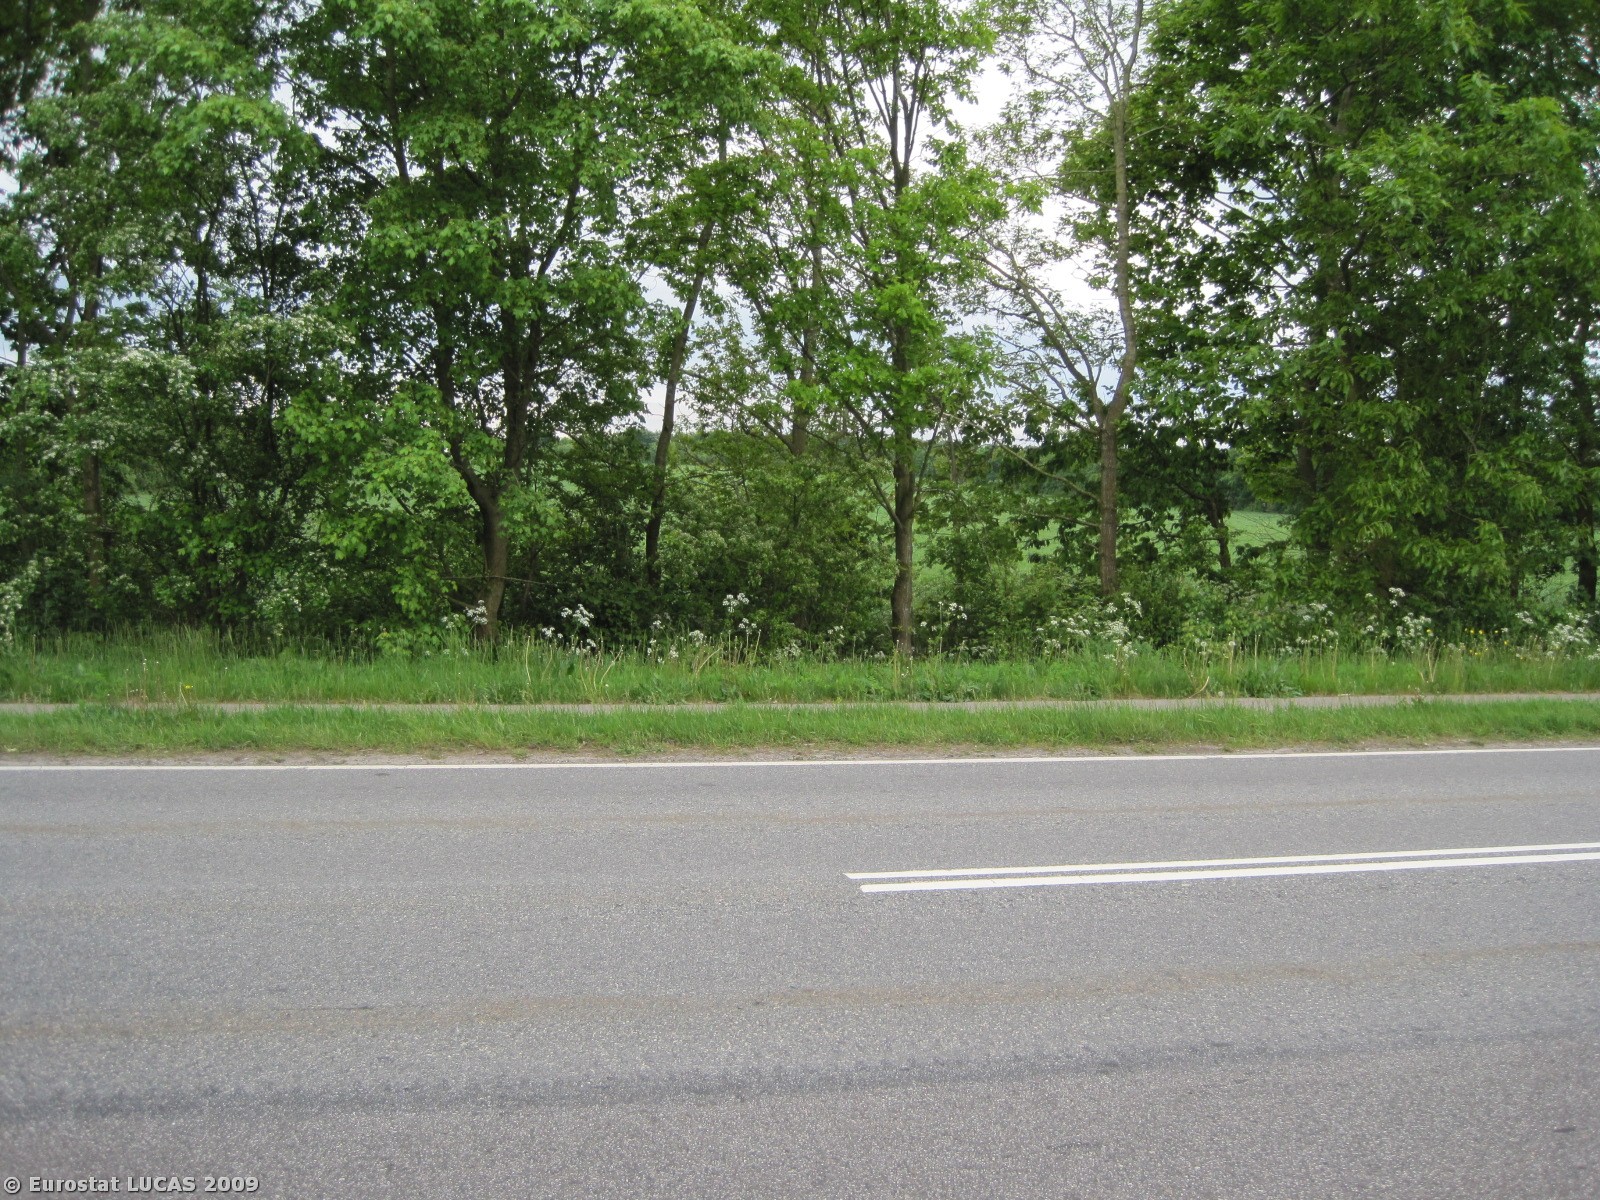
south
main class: Woodland
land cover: Broadleaved woodland
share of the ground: > 75 %
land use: Residential
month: May
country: DK
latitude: 56.7090
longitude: 10.0816
